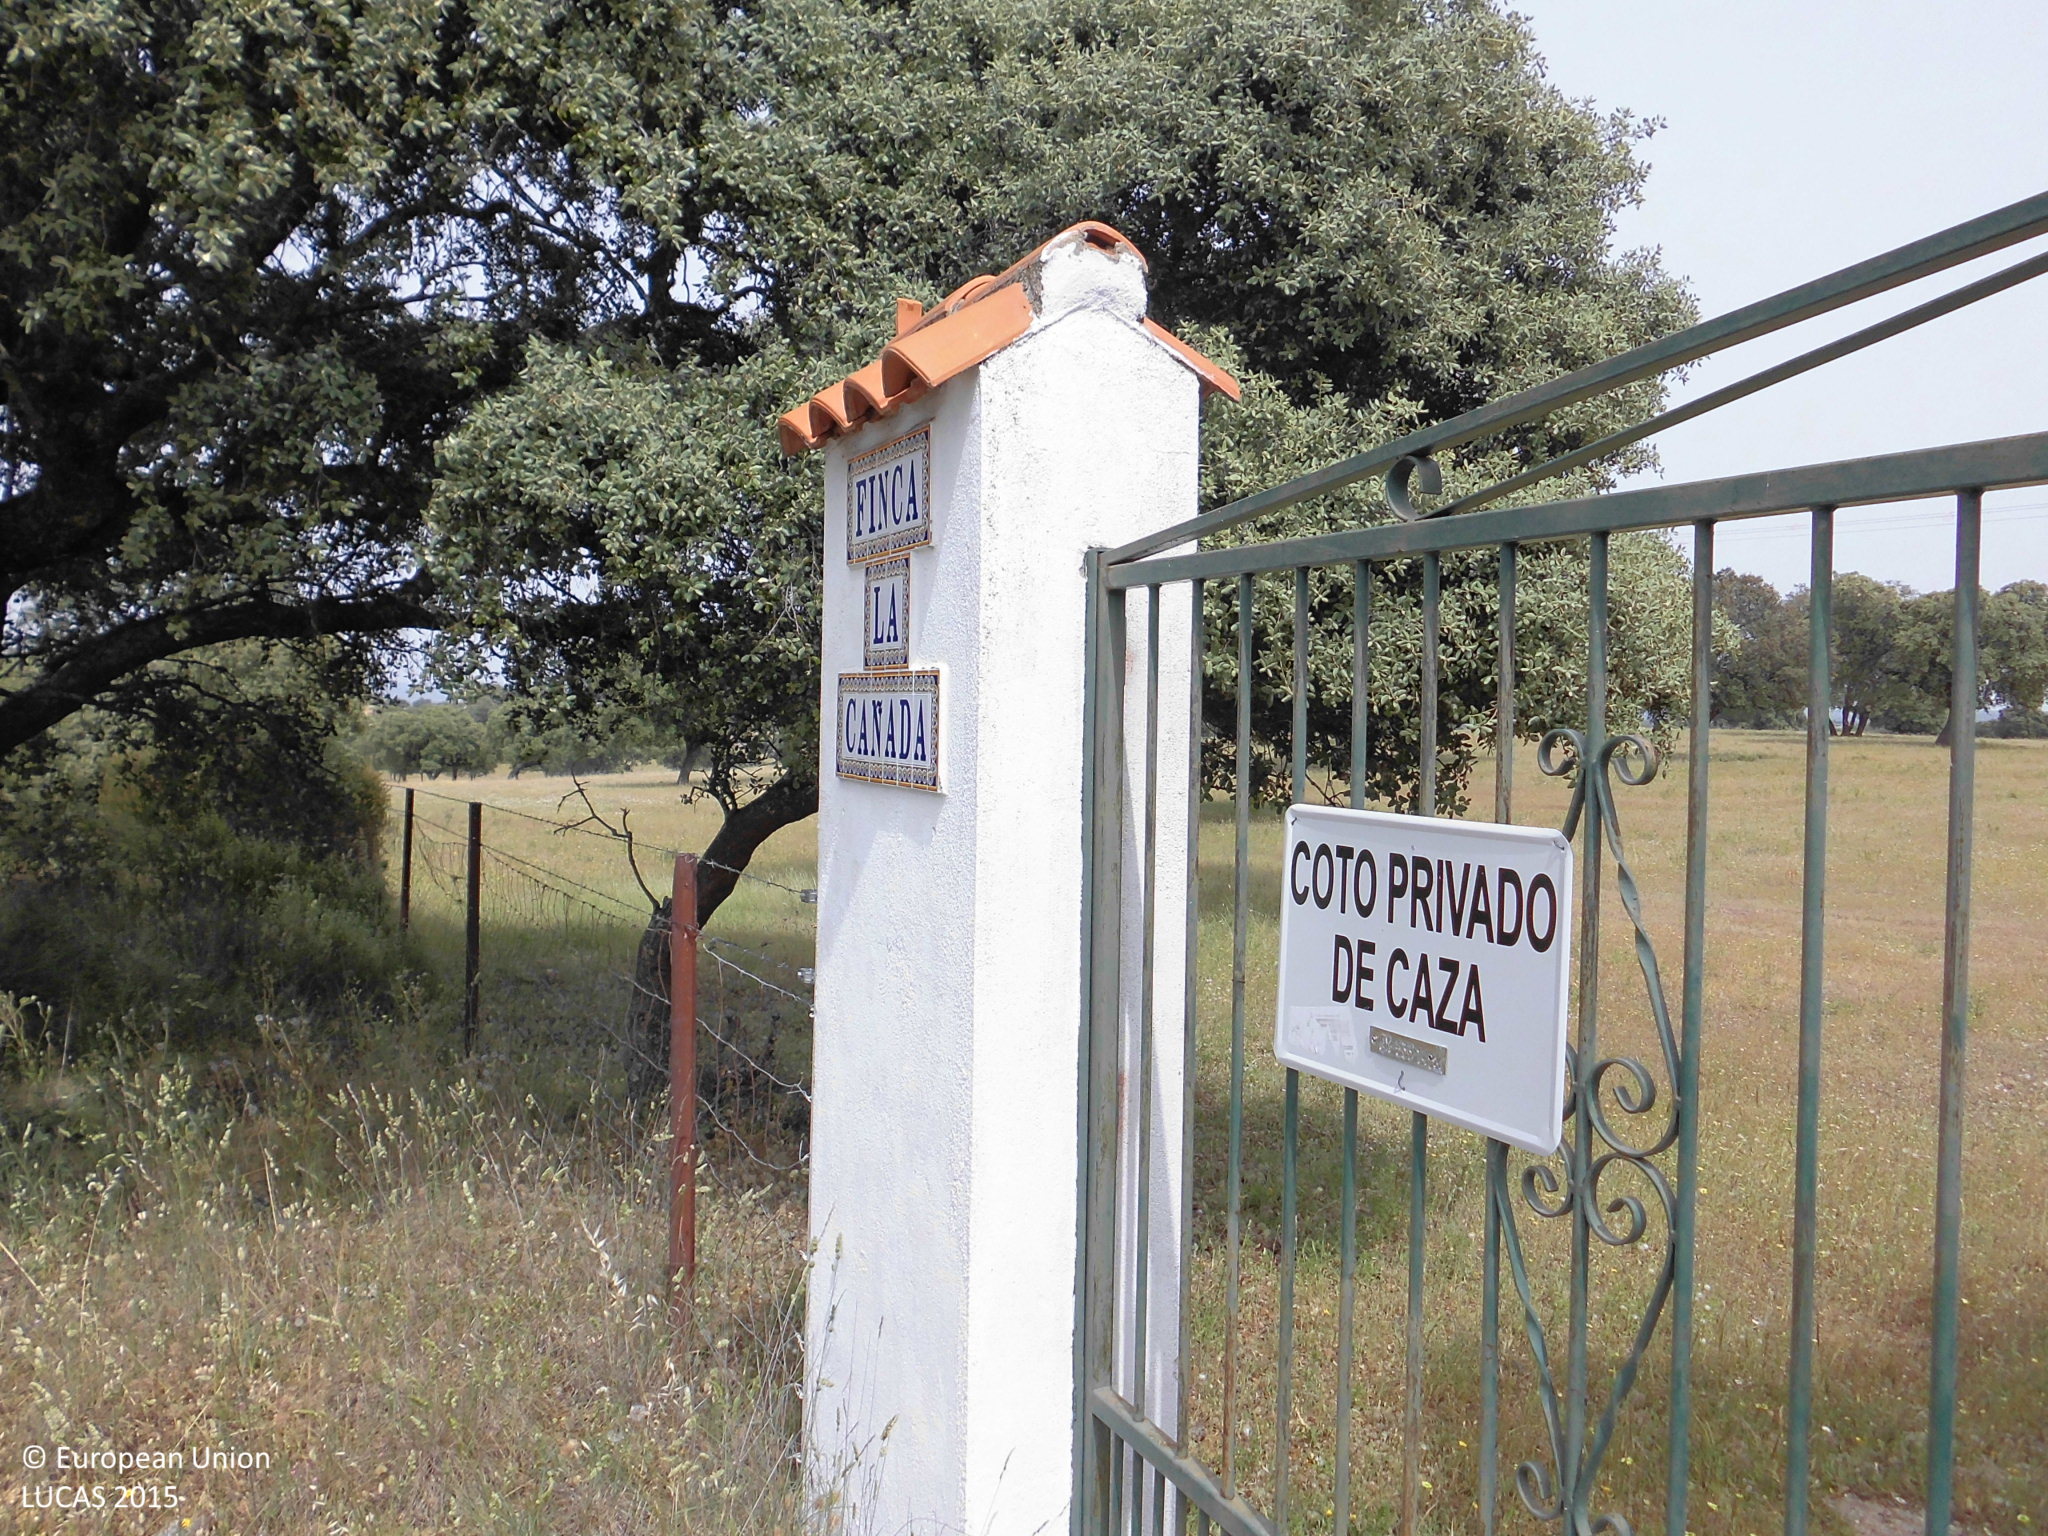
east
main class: Woodland
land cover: Broadleaved woodland
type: broadleaved evergreen forest
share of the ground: 10 - 25 %
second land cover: Grassland without tree/shrub cover
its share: > 75 %
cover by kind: herbaceous plants 90 %, broadleaved forest trees 10 %
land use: Forestry
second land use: Agriculture (excluding fallow land and kitchen gardens)
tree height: > 5 m
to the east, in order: Broadleaved woodland; Grassland without tree/shrub cover; Tracks; Broadleaved woodland
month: May
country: ES
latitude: 39.7182
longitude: -6.1068
